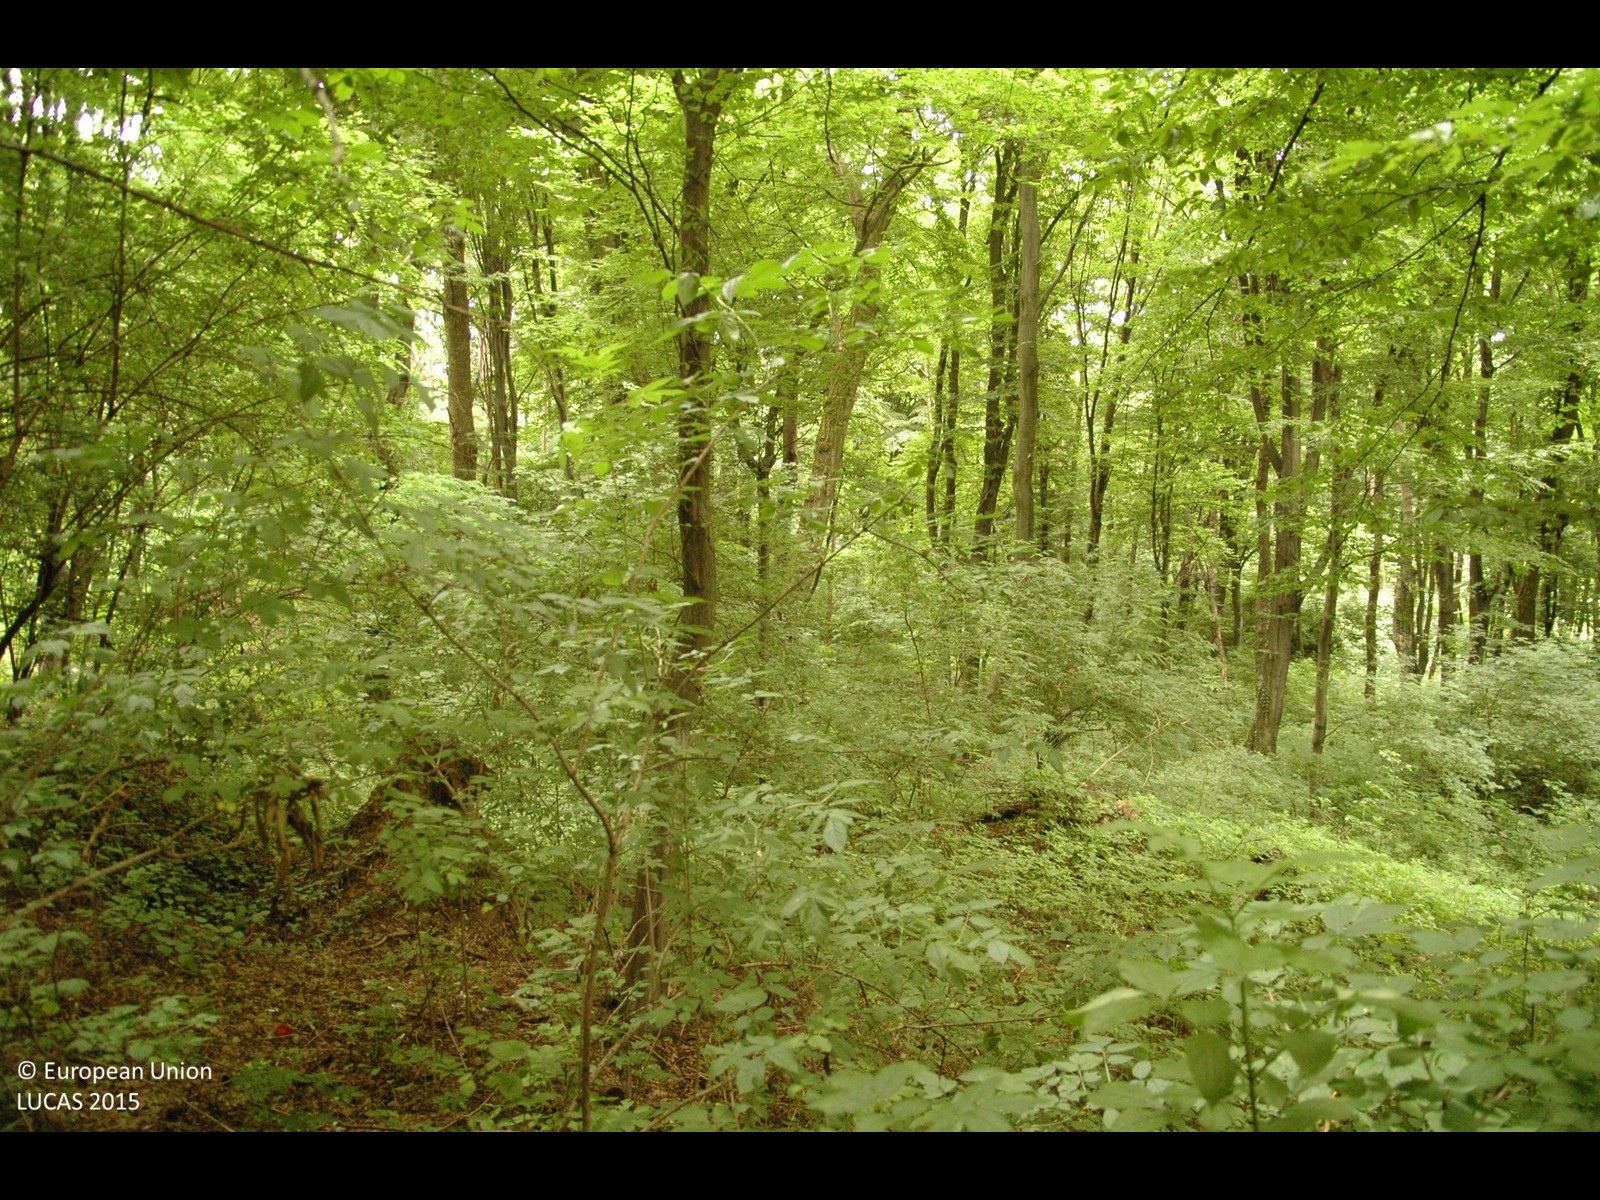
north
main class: Woodland
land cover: Broadleaved woodland
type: mesophytic deciduous forest
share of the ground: > 75 %
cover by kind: broadleaved forest trees 100 %
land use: Forestry
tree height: > 5 m
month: June
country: HR
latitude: 46.4505
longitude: 16.3666
